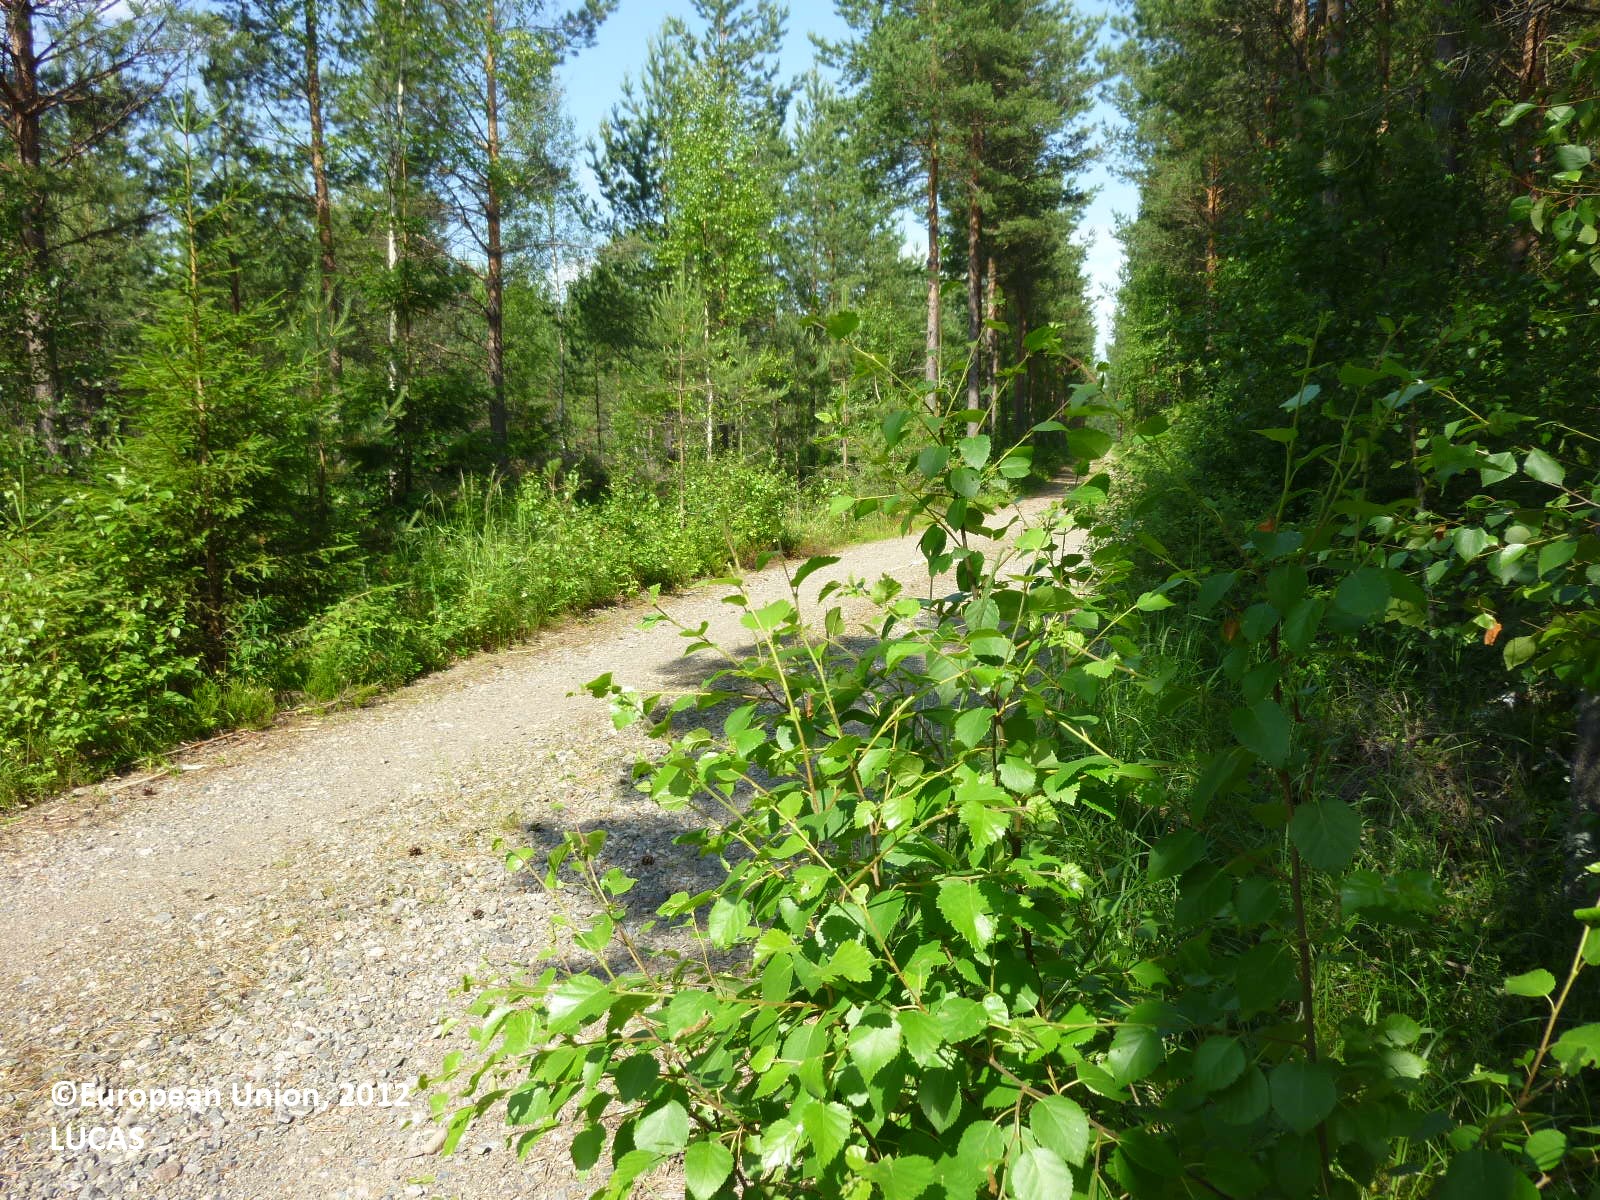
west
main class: Artificial land
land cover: Non built-up linear features
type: boreal forest
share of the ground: > 75 %
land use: Road transport
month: July
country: FI
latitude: 61.2337
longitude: 22.4521
